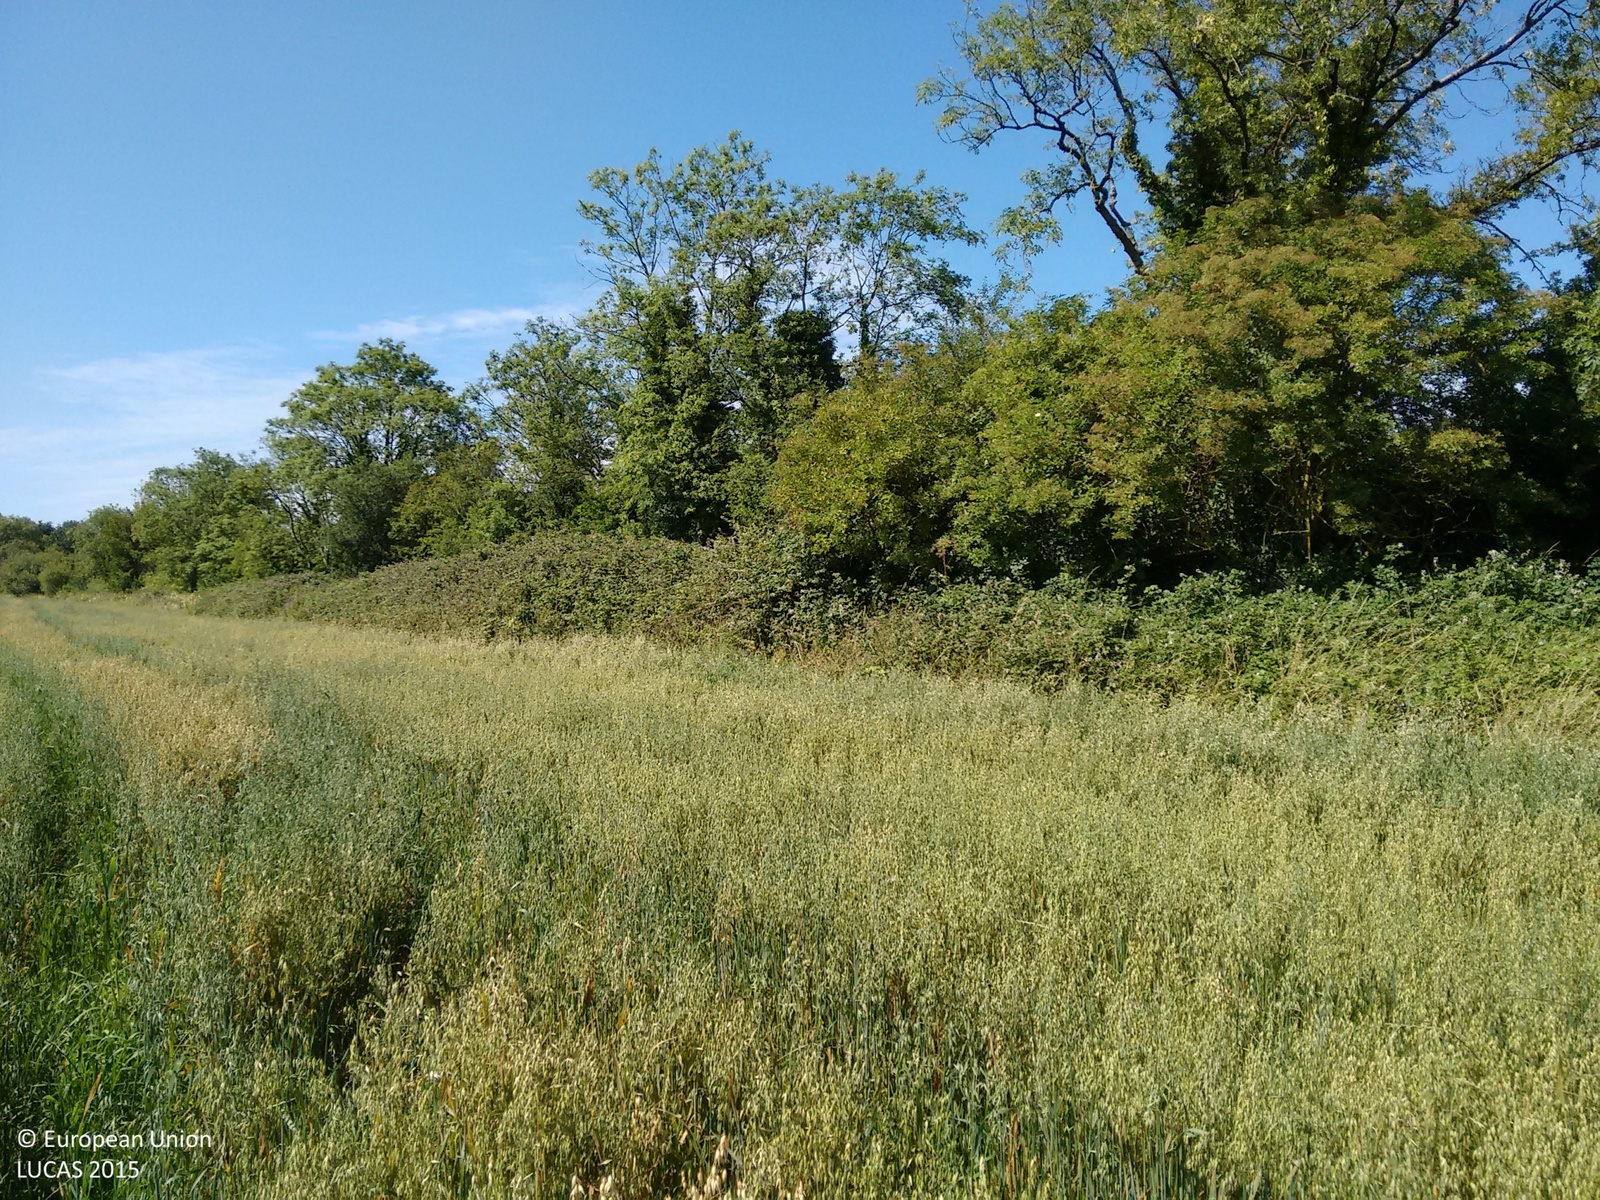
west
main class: Cropland
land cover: Oats
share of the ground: > 75 %
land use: Agriculture (excluding fallow land and kitchen gardens)
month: August
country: IE
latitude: 52.9210
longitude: -7.5165
